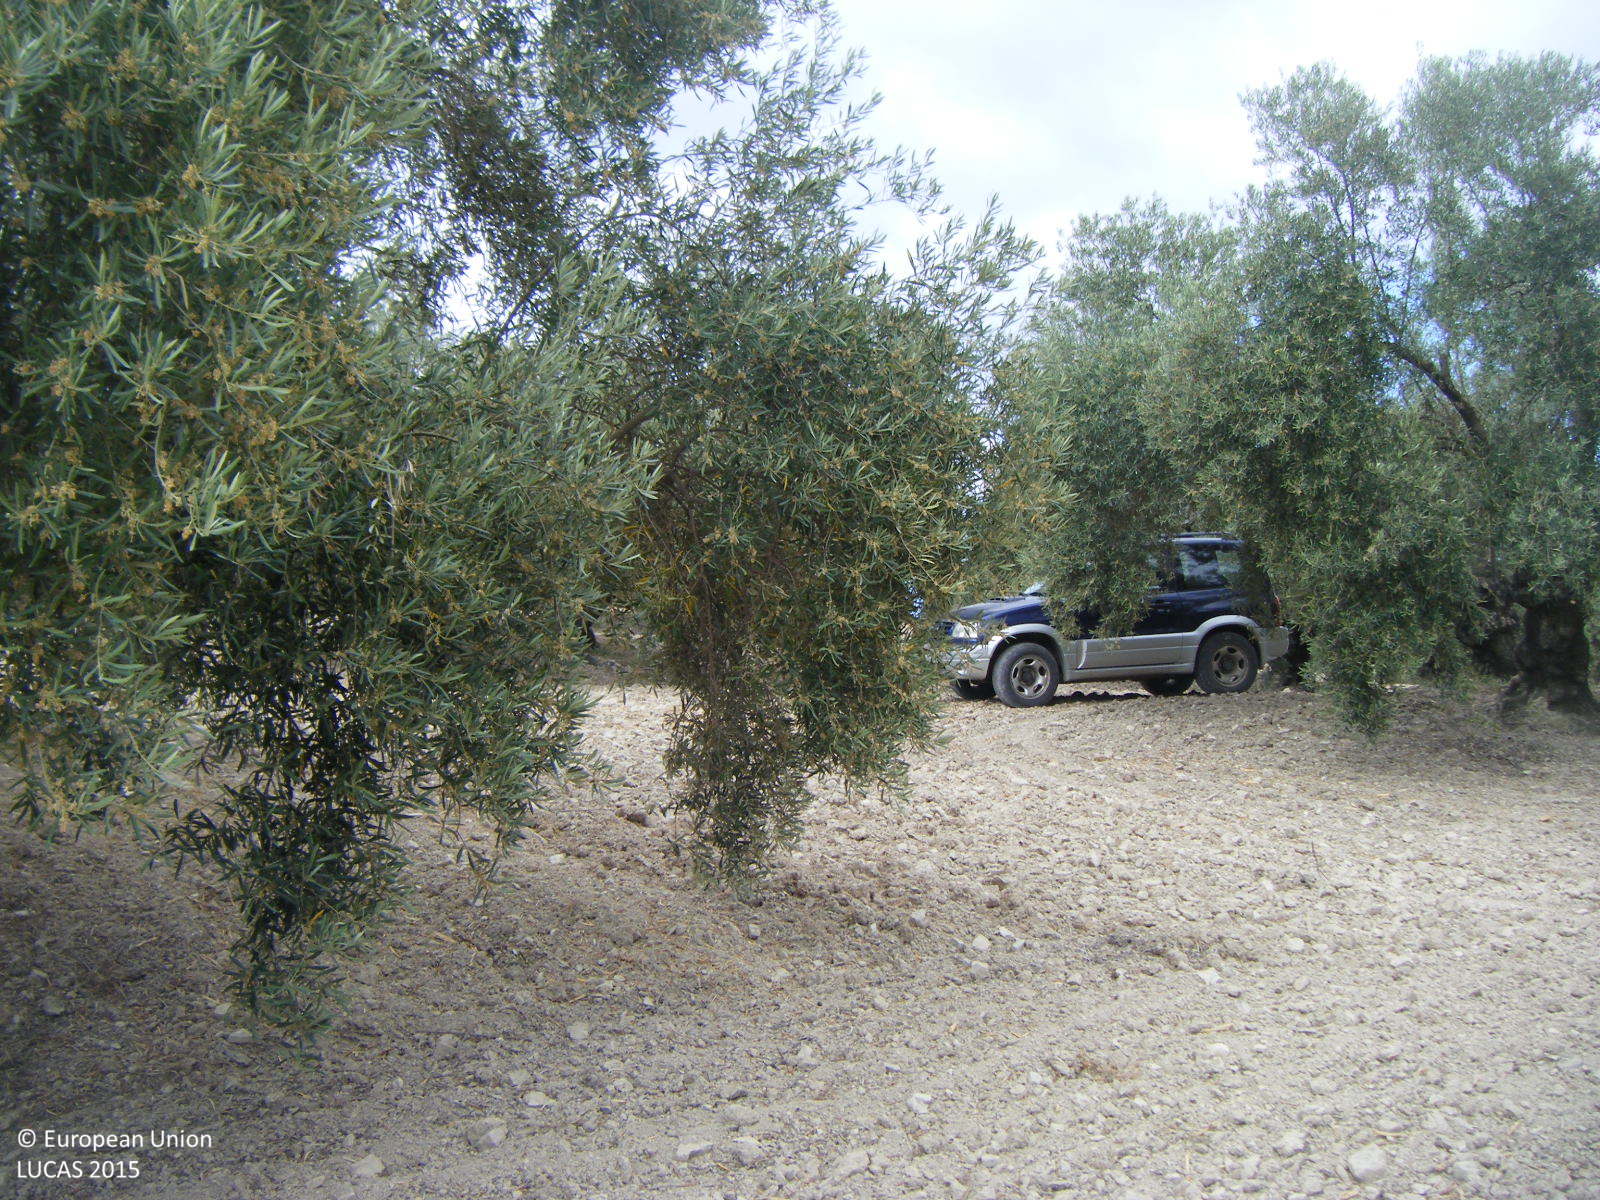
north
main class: Cropland
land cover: Olive groves
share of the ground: 10 - 25 %
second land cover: Other bare soil
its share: > 75 %
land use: Agriculture (excluding fallow land and kitchen gardens)
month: May
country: ES
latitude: 37.2137
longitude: -4.4109
